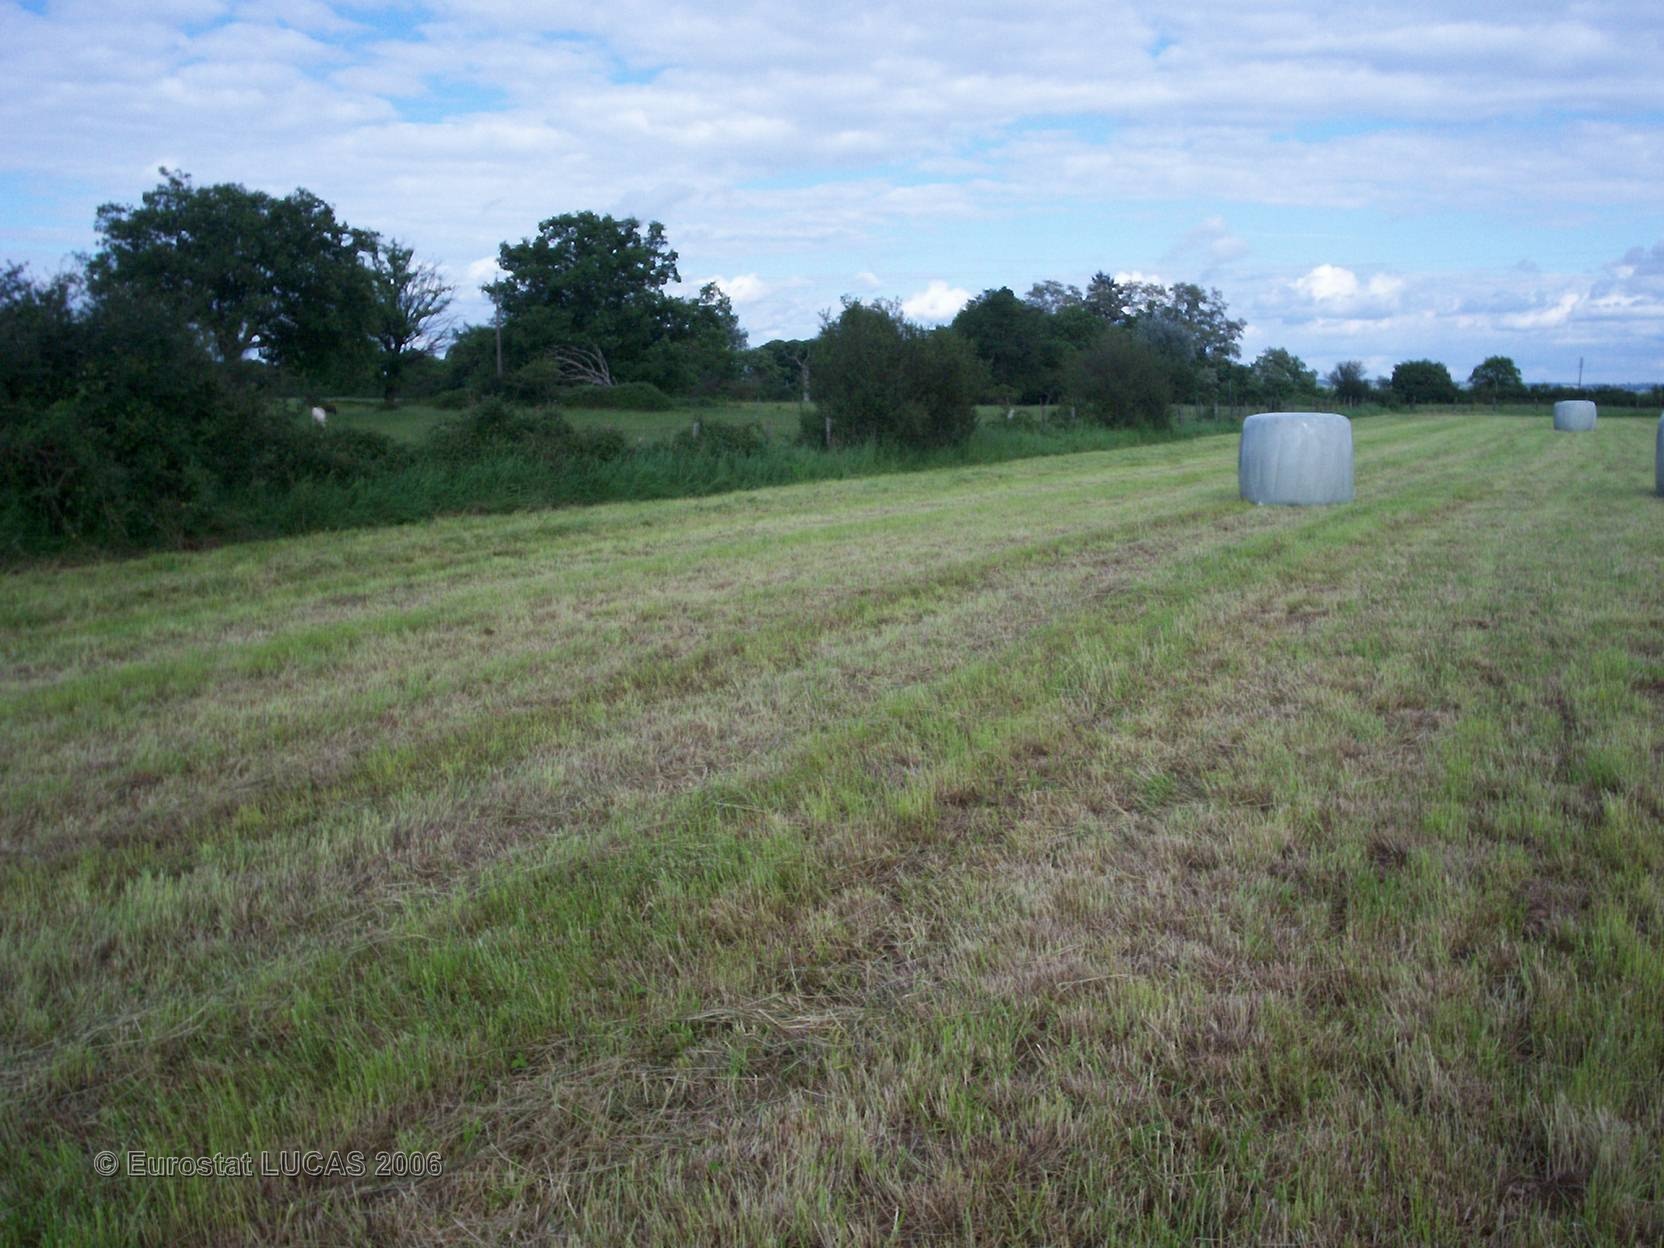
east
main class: Grassland
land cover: Grassland without tree/shrub cover
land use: Agriculture (excluding fallow land and kitchen gardens)
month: May
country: FR
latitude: 46.8289
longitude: 3.0352
